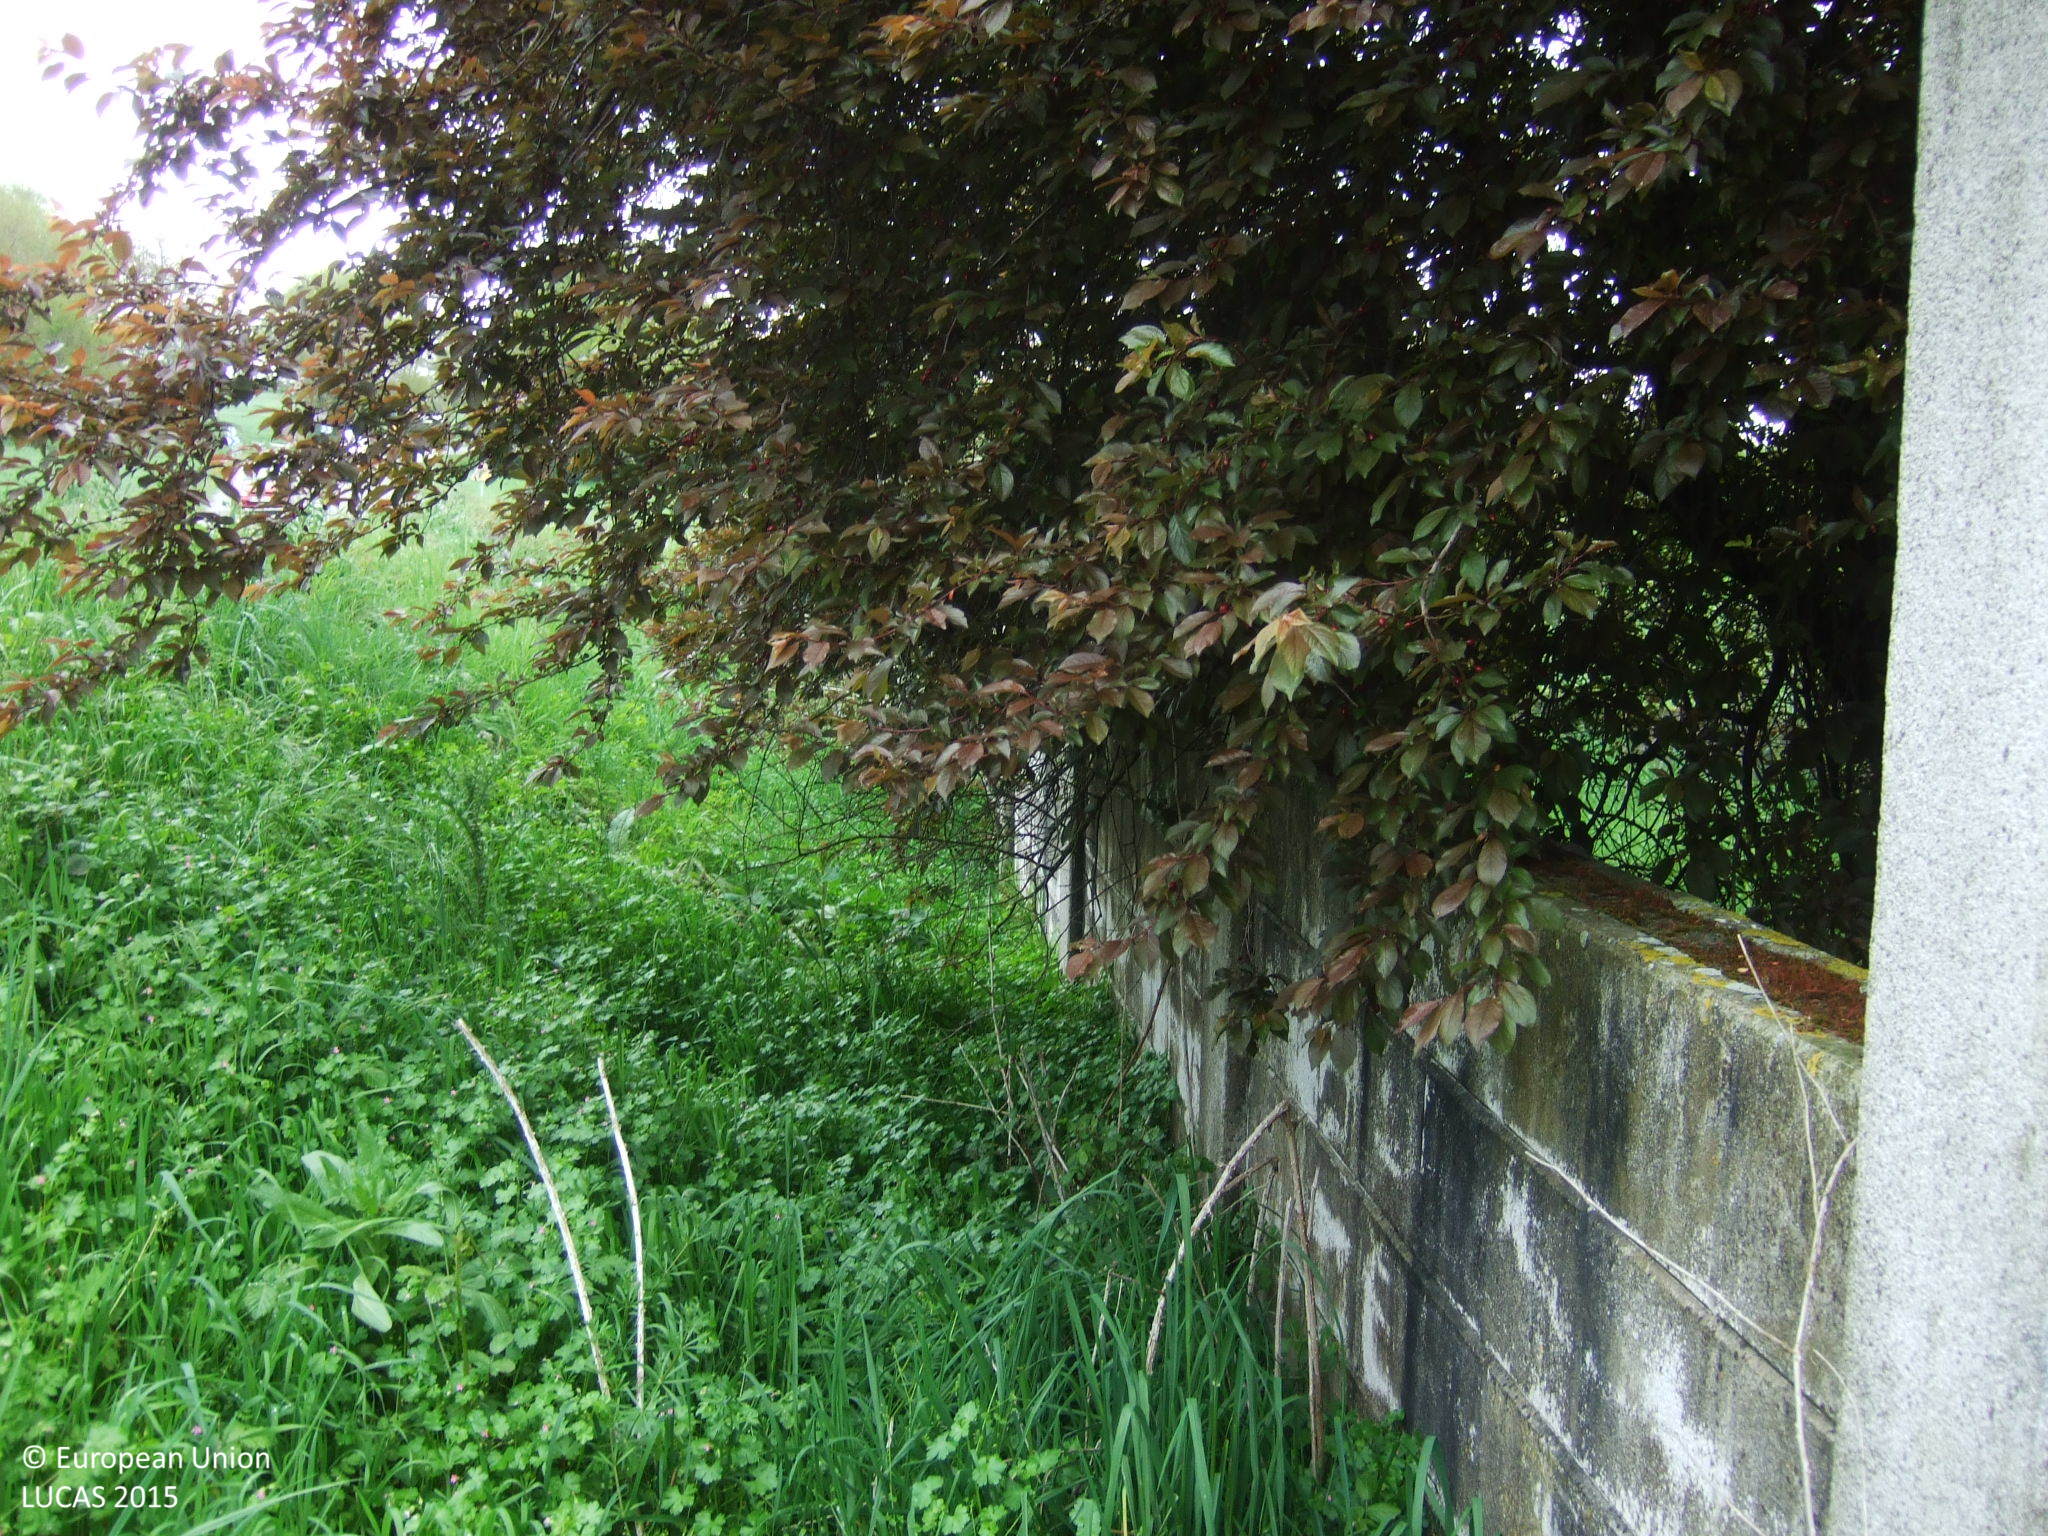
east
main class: Cropland
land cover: Apple fruit
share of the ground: 25 - 50 %
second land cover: Spontaneously vegetated surfaces
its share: > 75 %
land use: Kitchen garden
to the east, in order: Apple fruit; Spontaneously vegetated surfaces; Dry stone walls; Grassland without tree/shrub cover; Groves; Temporary grasslands; Electric lines; Dry stone walls; Broadleaved woodland; Temporary grasslands; Fences; Grassland without tree/shrub cover; Spontaneously vegetated surfaces; Other bare soil; Artificial constructions in urban areas
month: April
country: ES
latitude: 42.8914
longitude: -7.5746
